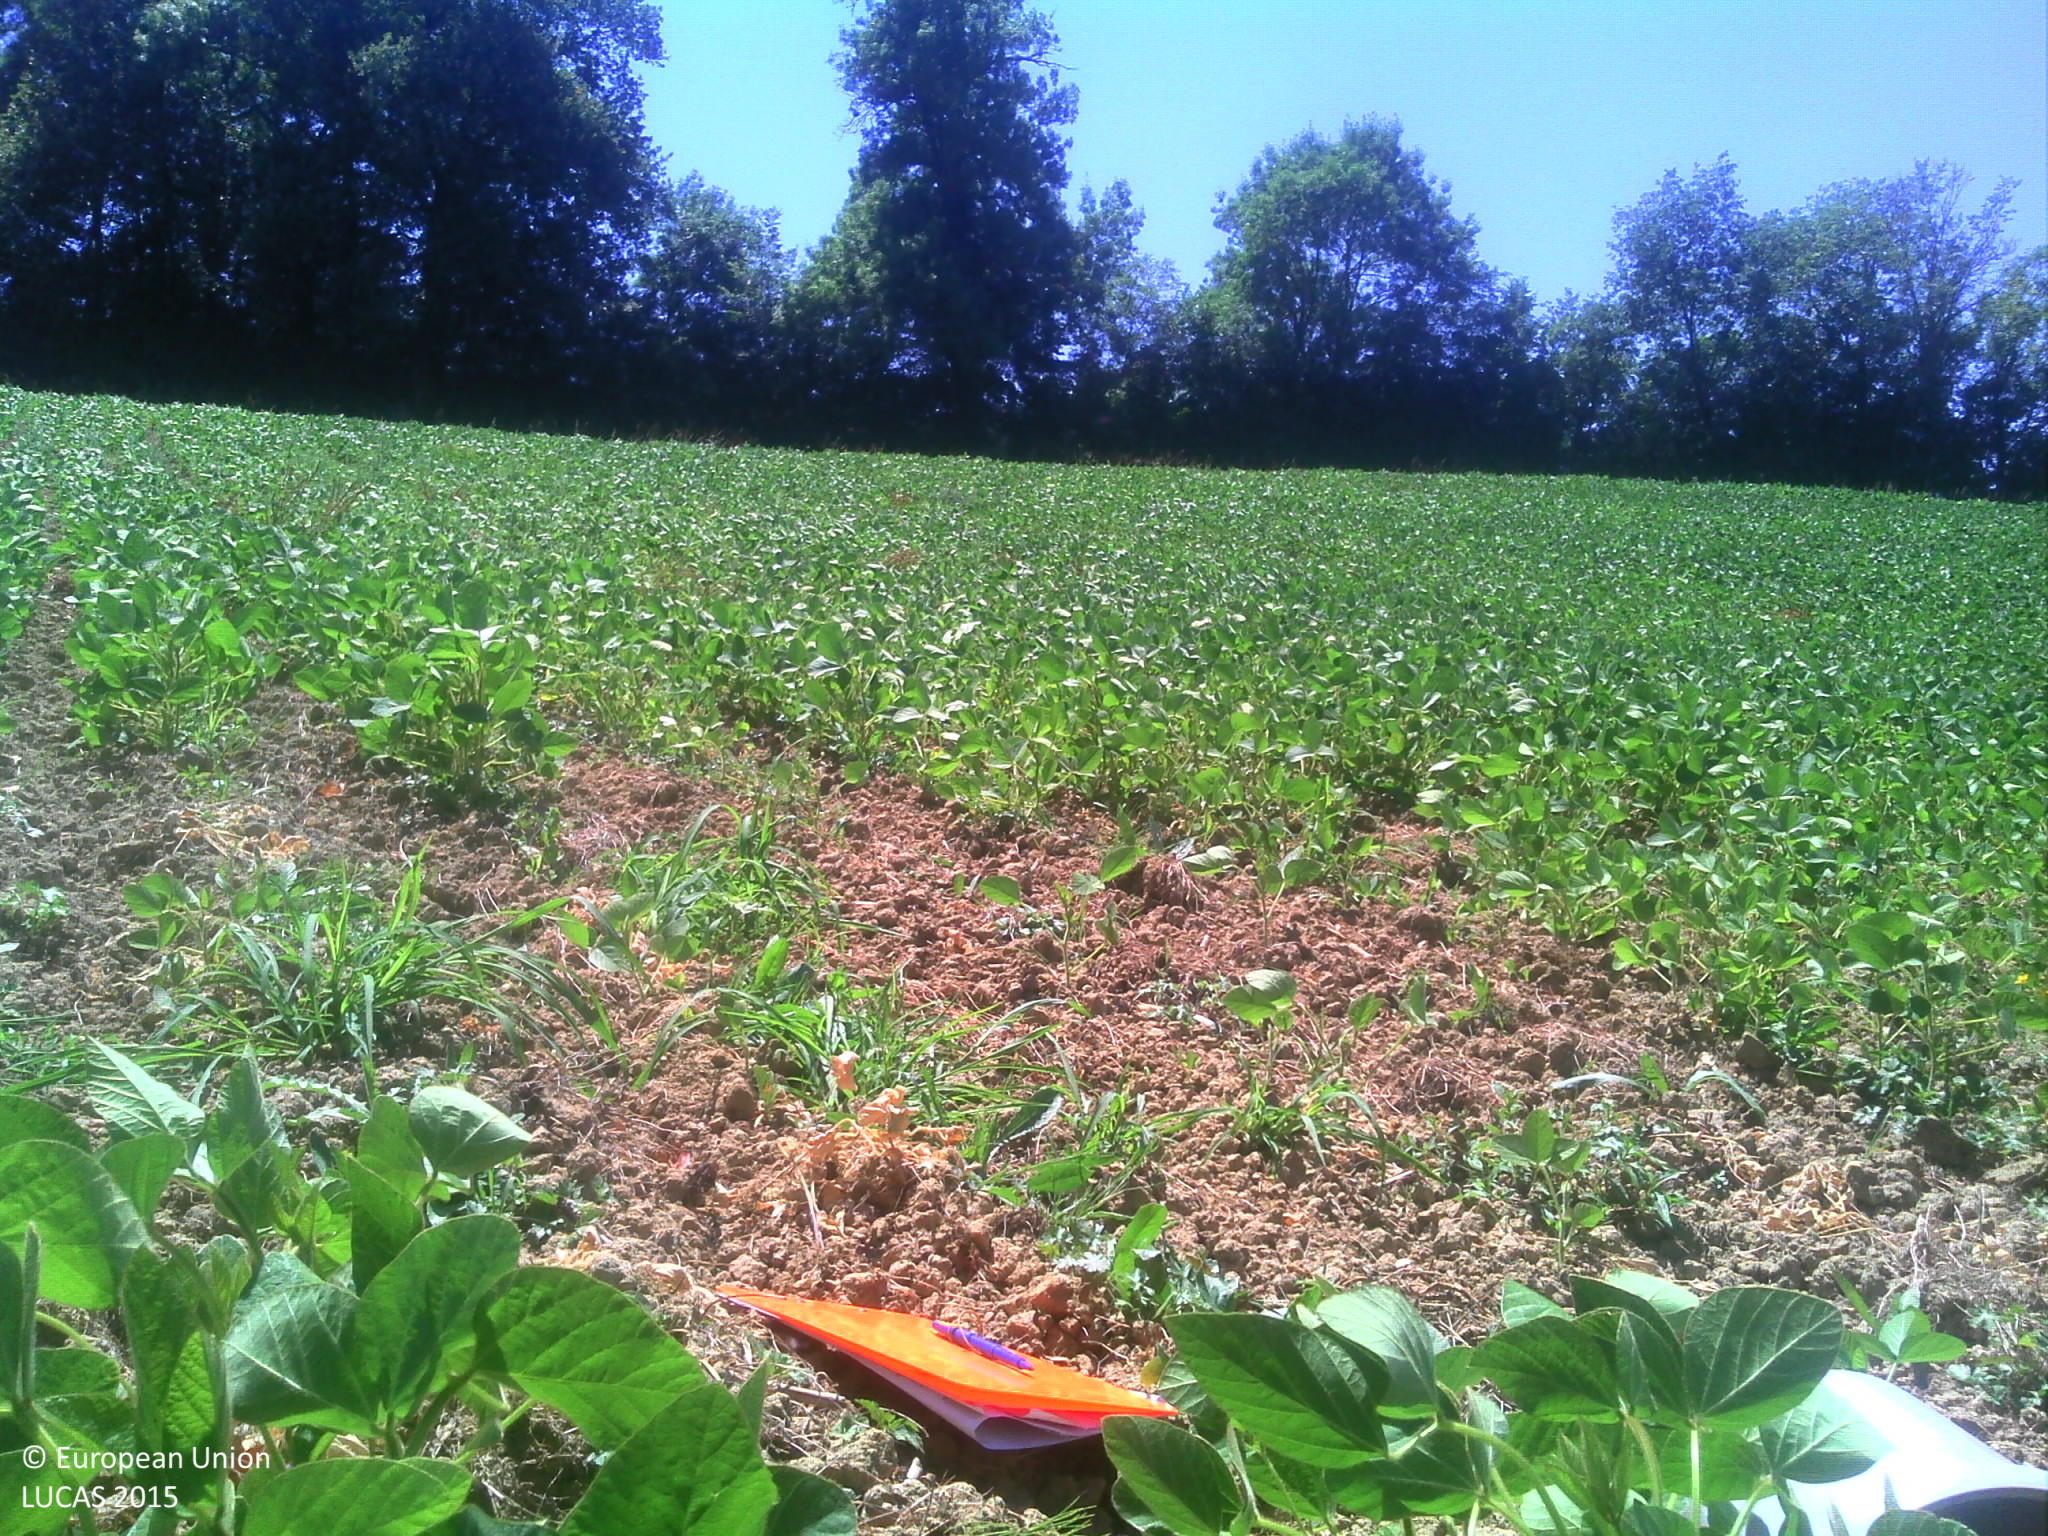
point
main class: Cropland
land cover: Soya
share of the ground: > 75 %
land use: Agriculture (excluding fallow land and kitchen gardens)
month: July
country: FR
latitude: 43.4366
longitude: 1.0445
